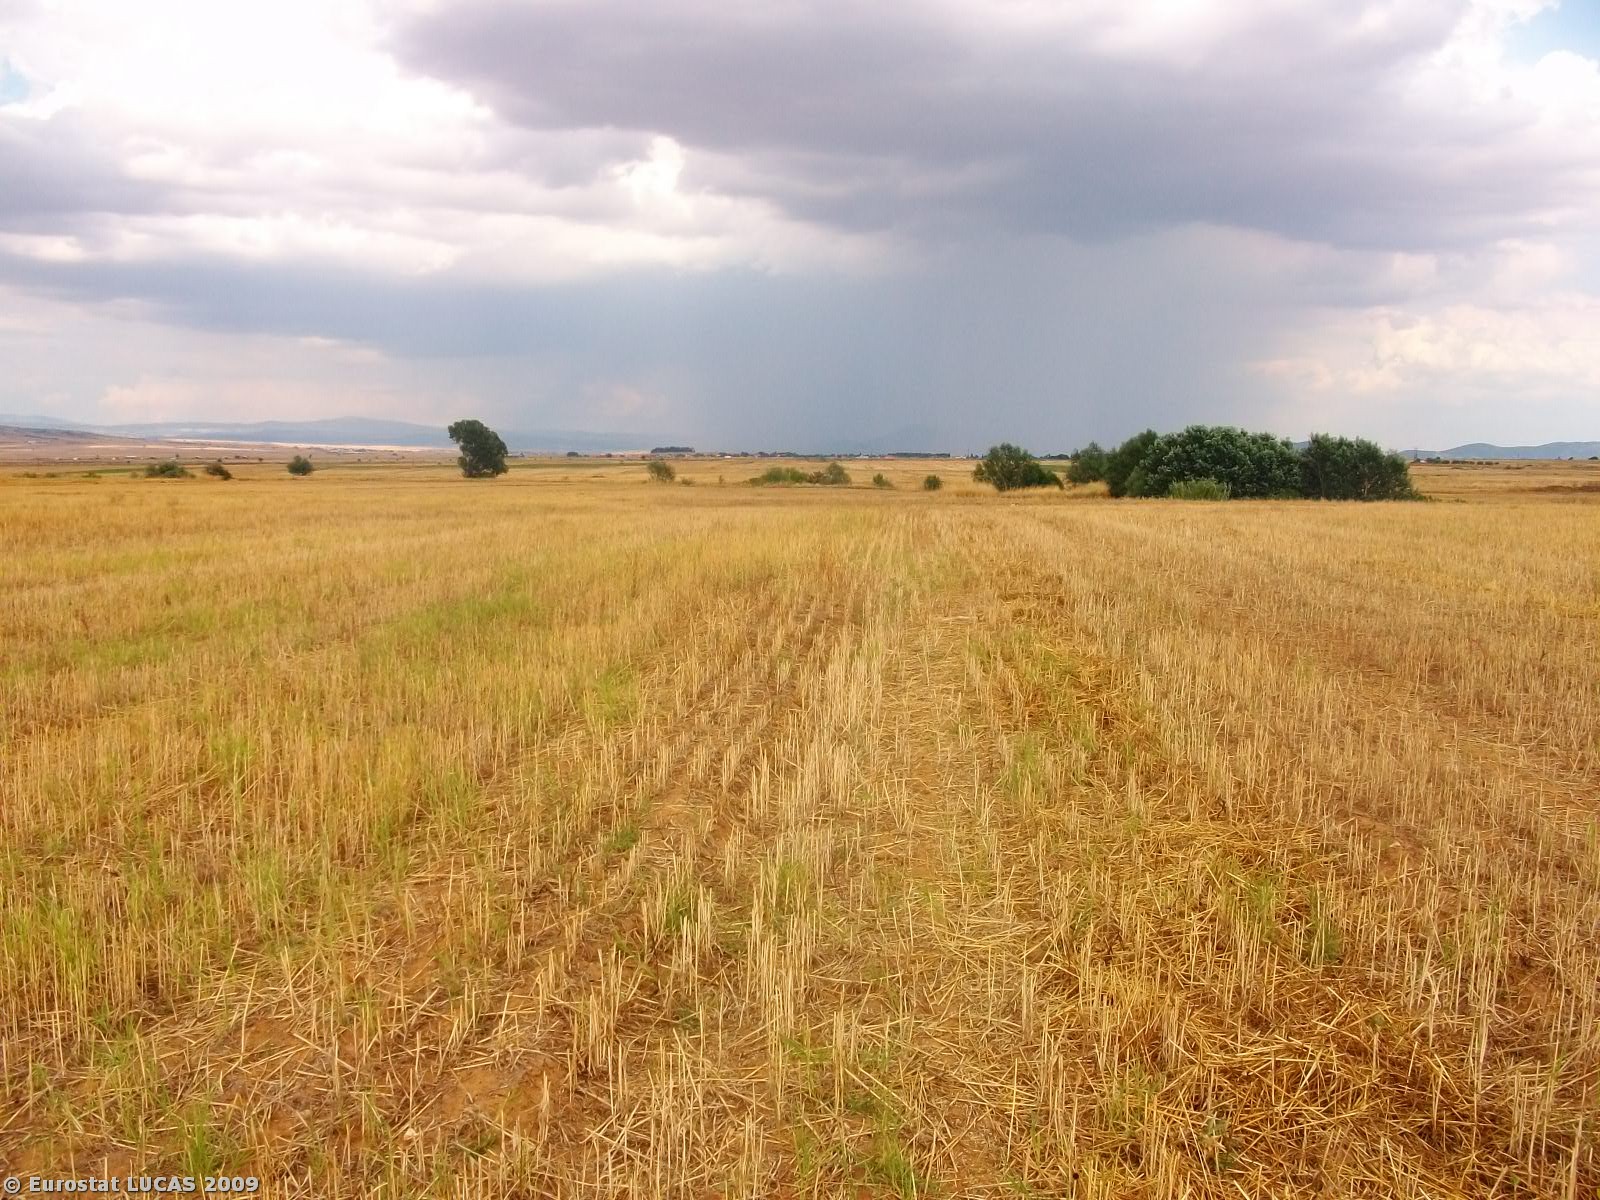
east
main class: Cropland
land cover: Common wheat
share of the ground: > 75 %
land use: Agriculture (excluding fallow land and kitchen gardens)
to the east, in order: Common wheat; Tracks; Durum wheat; Shruby margins; Abandoned hedges; Inland running water
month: June
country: GR
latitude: 40.8420
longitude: 22.7331
